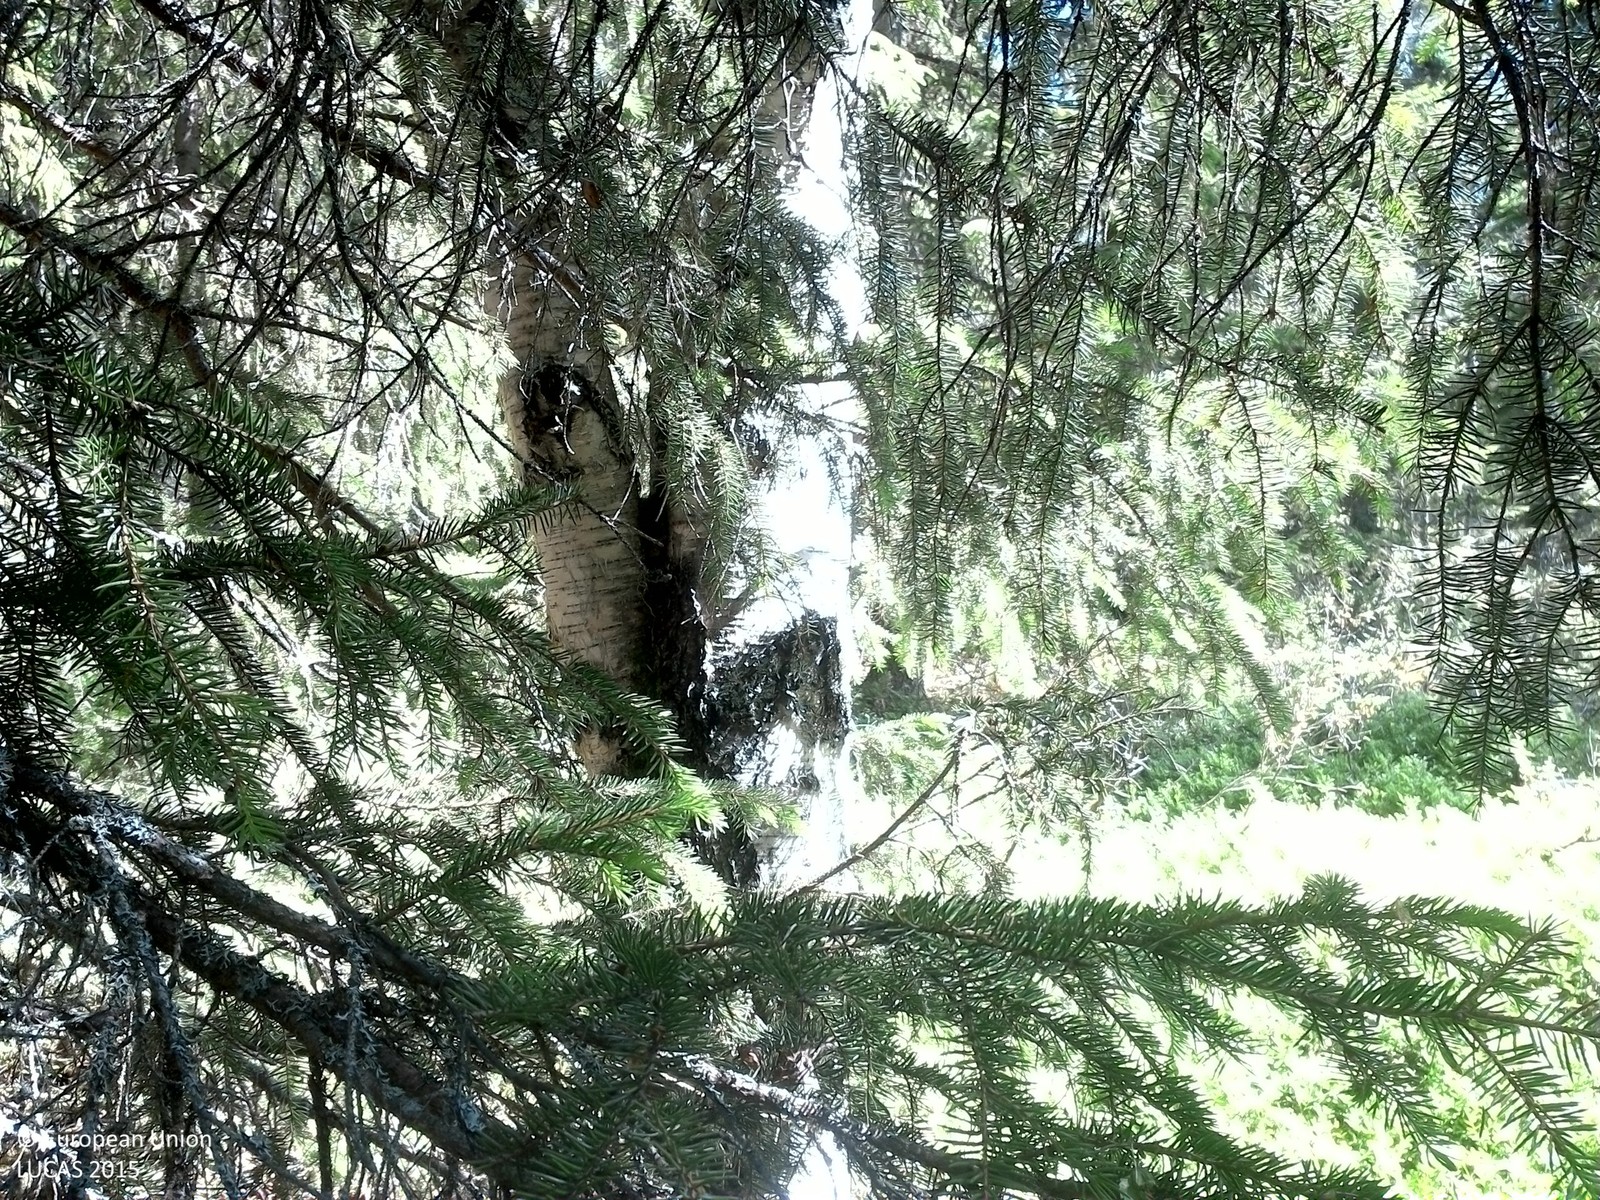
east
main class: Woodland
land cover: Spruce dominated mixed woodland
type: boreal forest
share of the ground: 50 - 75 %
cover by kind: coniferous forest trees 55 %, broadleaved forest trees 20 %, shrubs 15 %, herbaceous plants 5 %, lichens and mosses 5 %
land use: Forestry
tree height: > 5 m
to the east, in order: Spruce dominated mixed woodland; Pine dominated mixed woodland; Spruce dominated coniferous woodland; Grass margins; Paved roads, cycling and walking lanes; Ditches and canals; Spruce dominated mixed woodland; Spruce dominated coniferous woodland
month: July
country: SE
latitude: 64.2542
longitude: 16.7575
